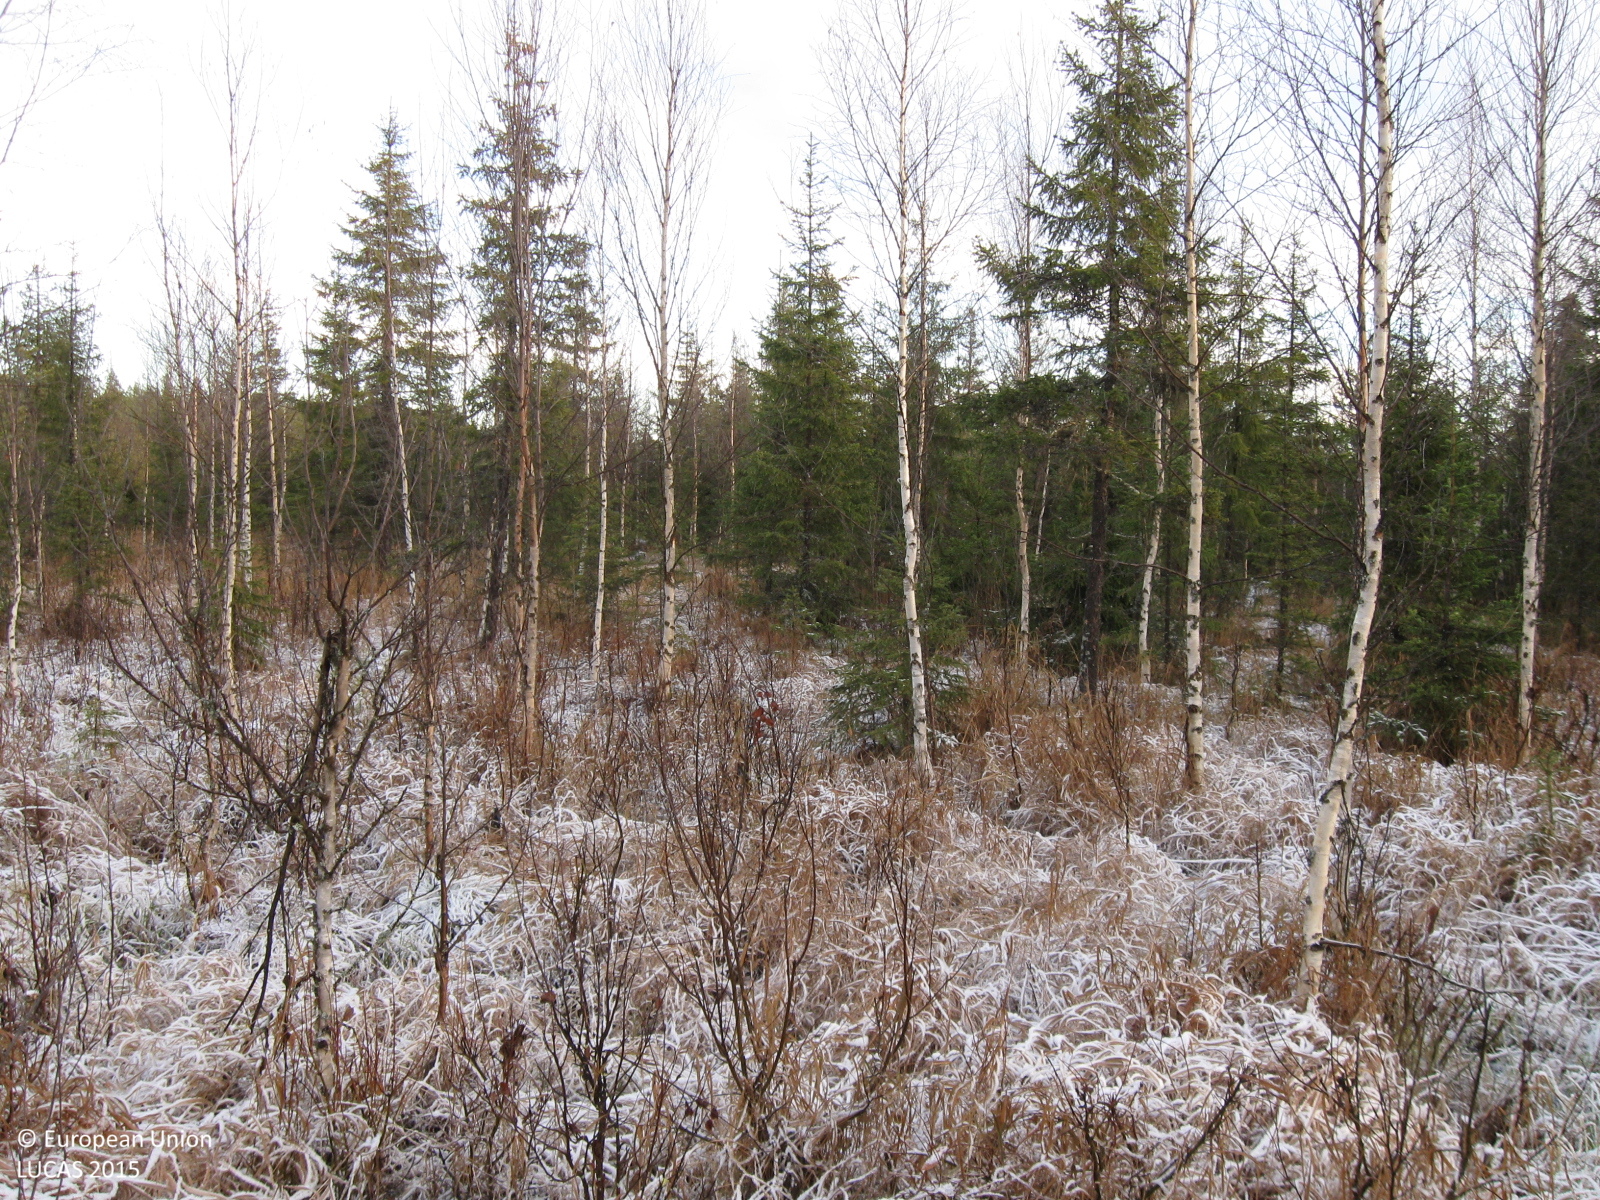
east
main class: Woodland
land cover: Spruce dominated mixed woodland
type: mire and swamp forests
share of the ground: 25 - 50 %
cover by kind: herbaceous plants 65 %, broadleaved forest trees 25 %, coniferous forest trees 10 %
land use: Forestry
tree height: < 5 m
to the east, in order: Spruce dominated mixed woodland; Rivers and streams; Spruce dominated mixed woodland; Spruce dominated coniferous woodland; Other coniferous woodland; Spruce dominated coniferous woodland; Other coniferous woodland
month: October
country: SE
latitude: 66.2793
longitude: 20.7645
